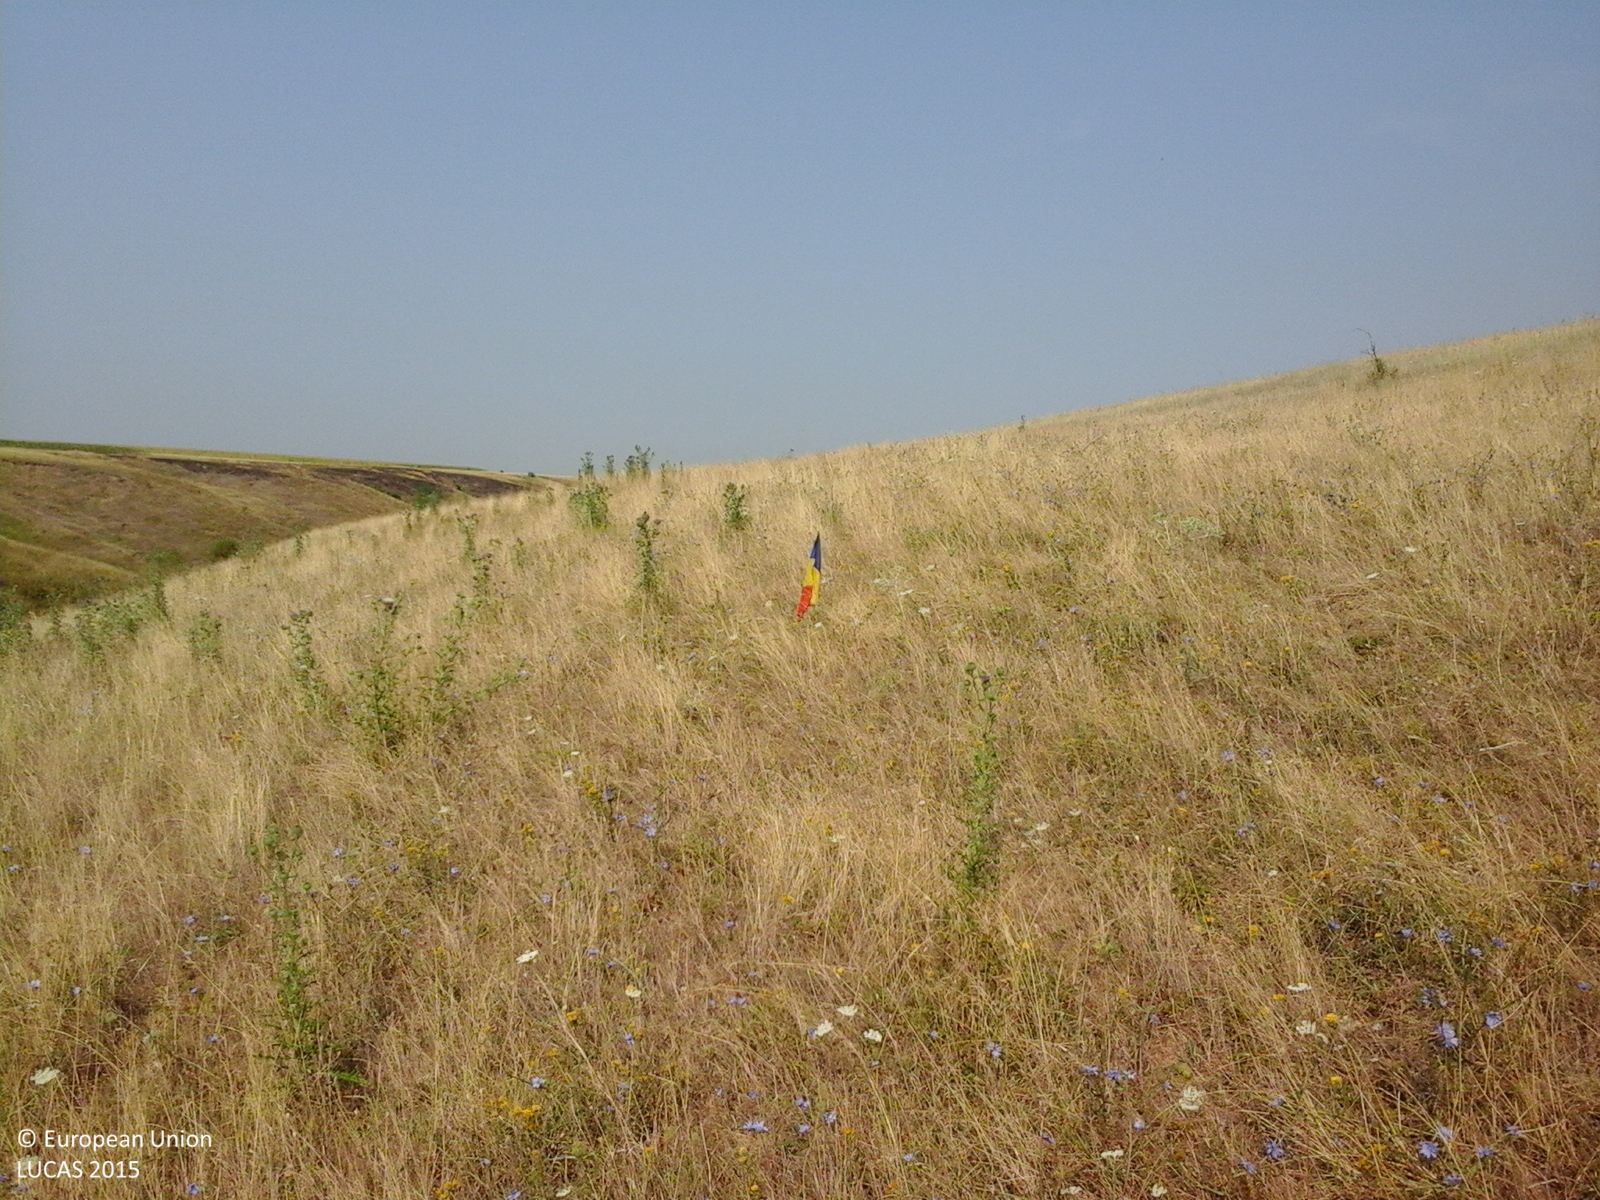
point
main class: Grassland
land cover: Grassland without tree/shrub cover
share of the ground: > 75 %
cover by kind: herbaceous plants 100 %
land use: Agriculture (excluding fallow land and kitchen gardens)
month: August
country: RO
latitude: 44.4403
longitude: 23.1517
